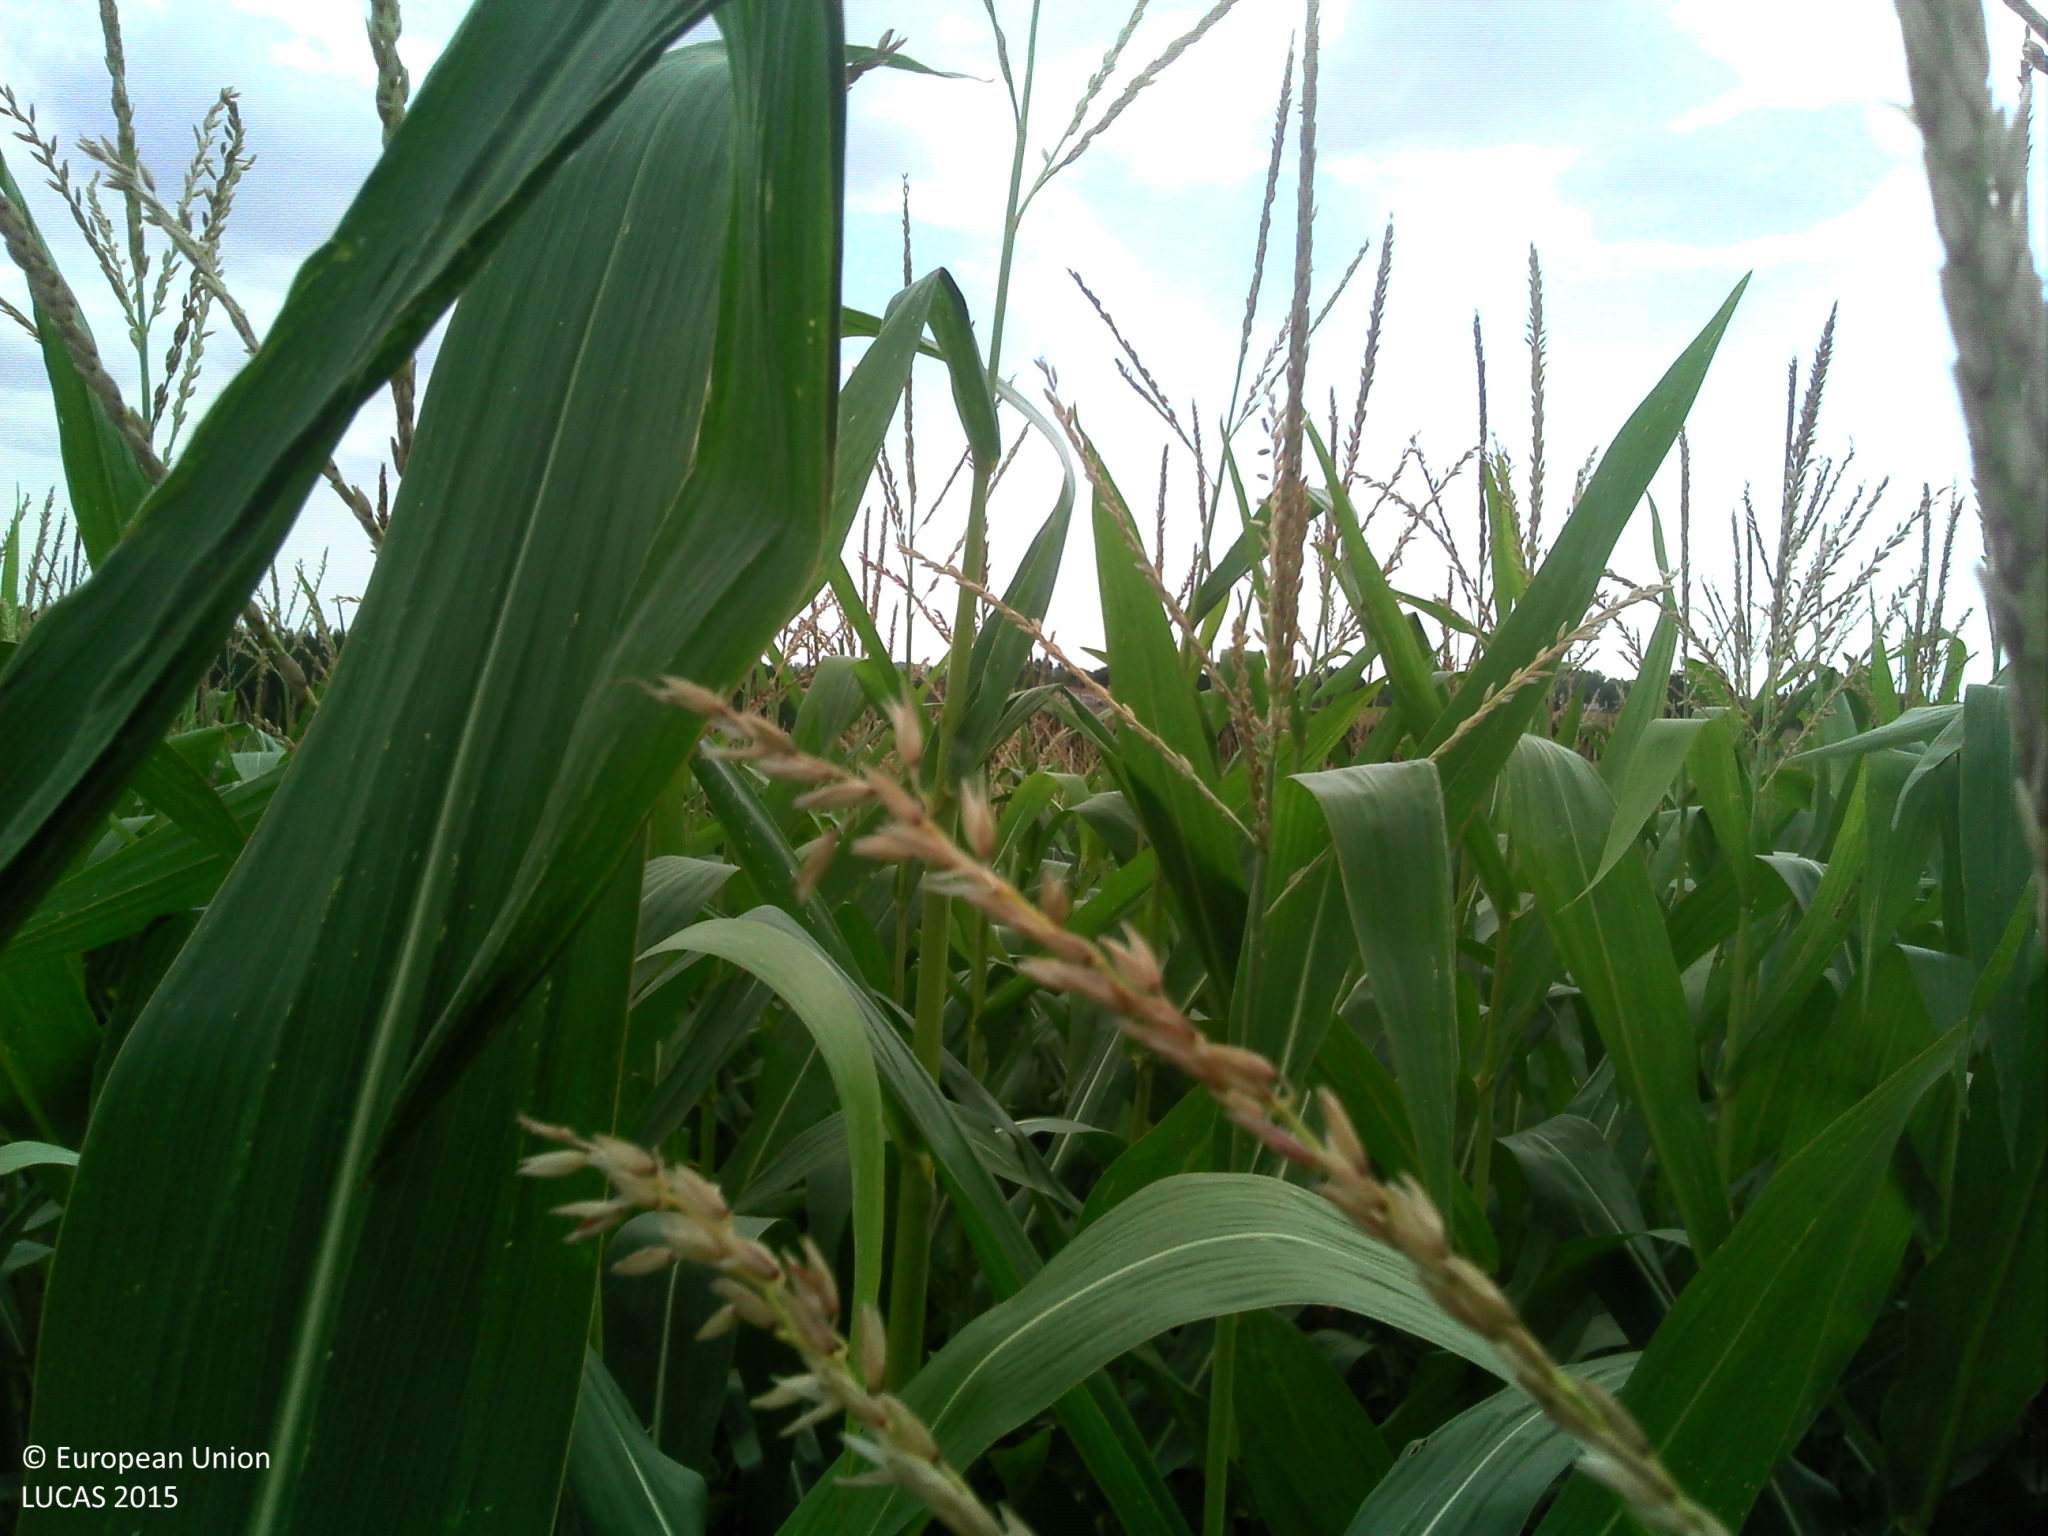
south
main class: Cropland
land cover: Maize
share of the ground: > 75 %
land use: Agriculture (excluding fallow land and kitchen gardens)
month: August
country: FR
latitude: 46.6234
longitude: -1.1217
